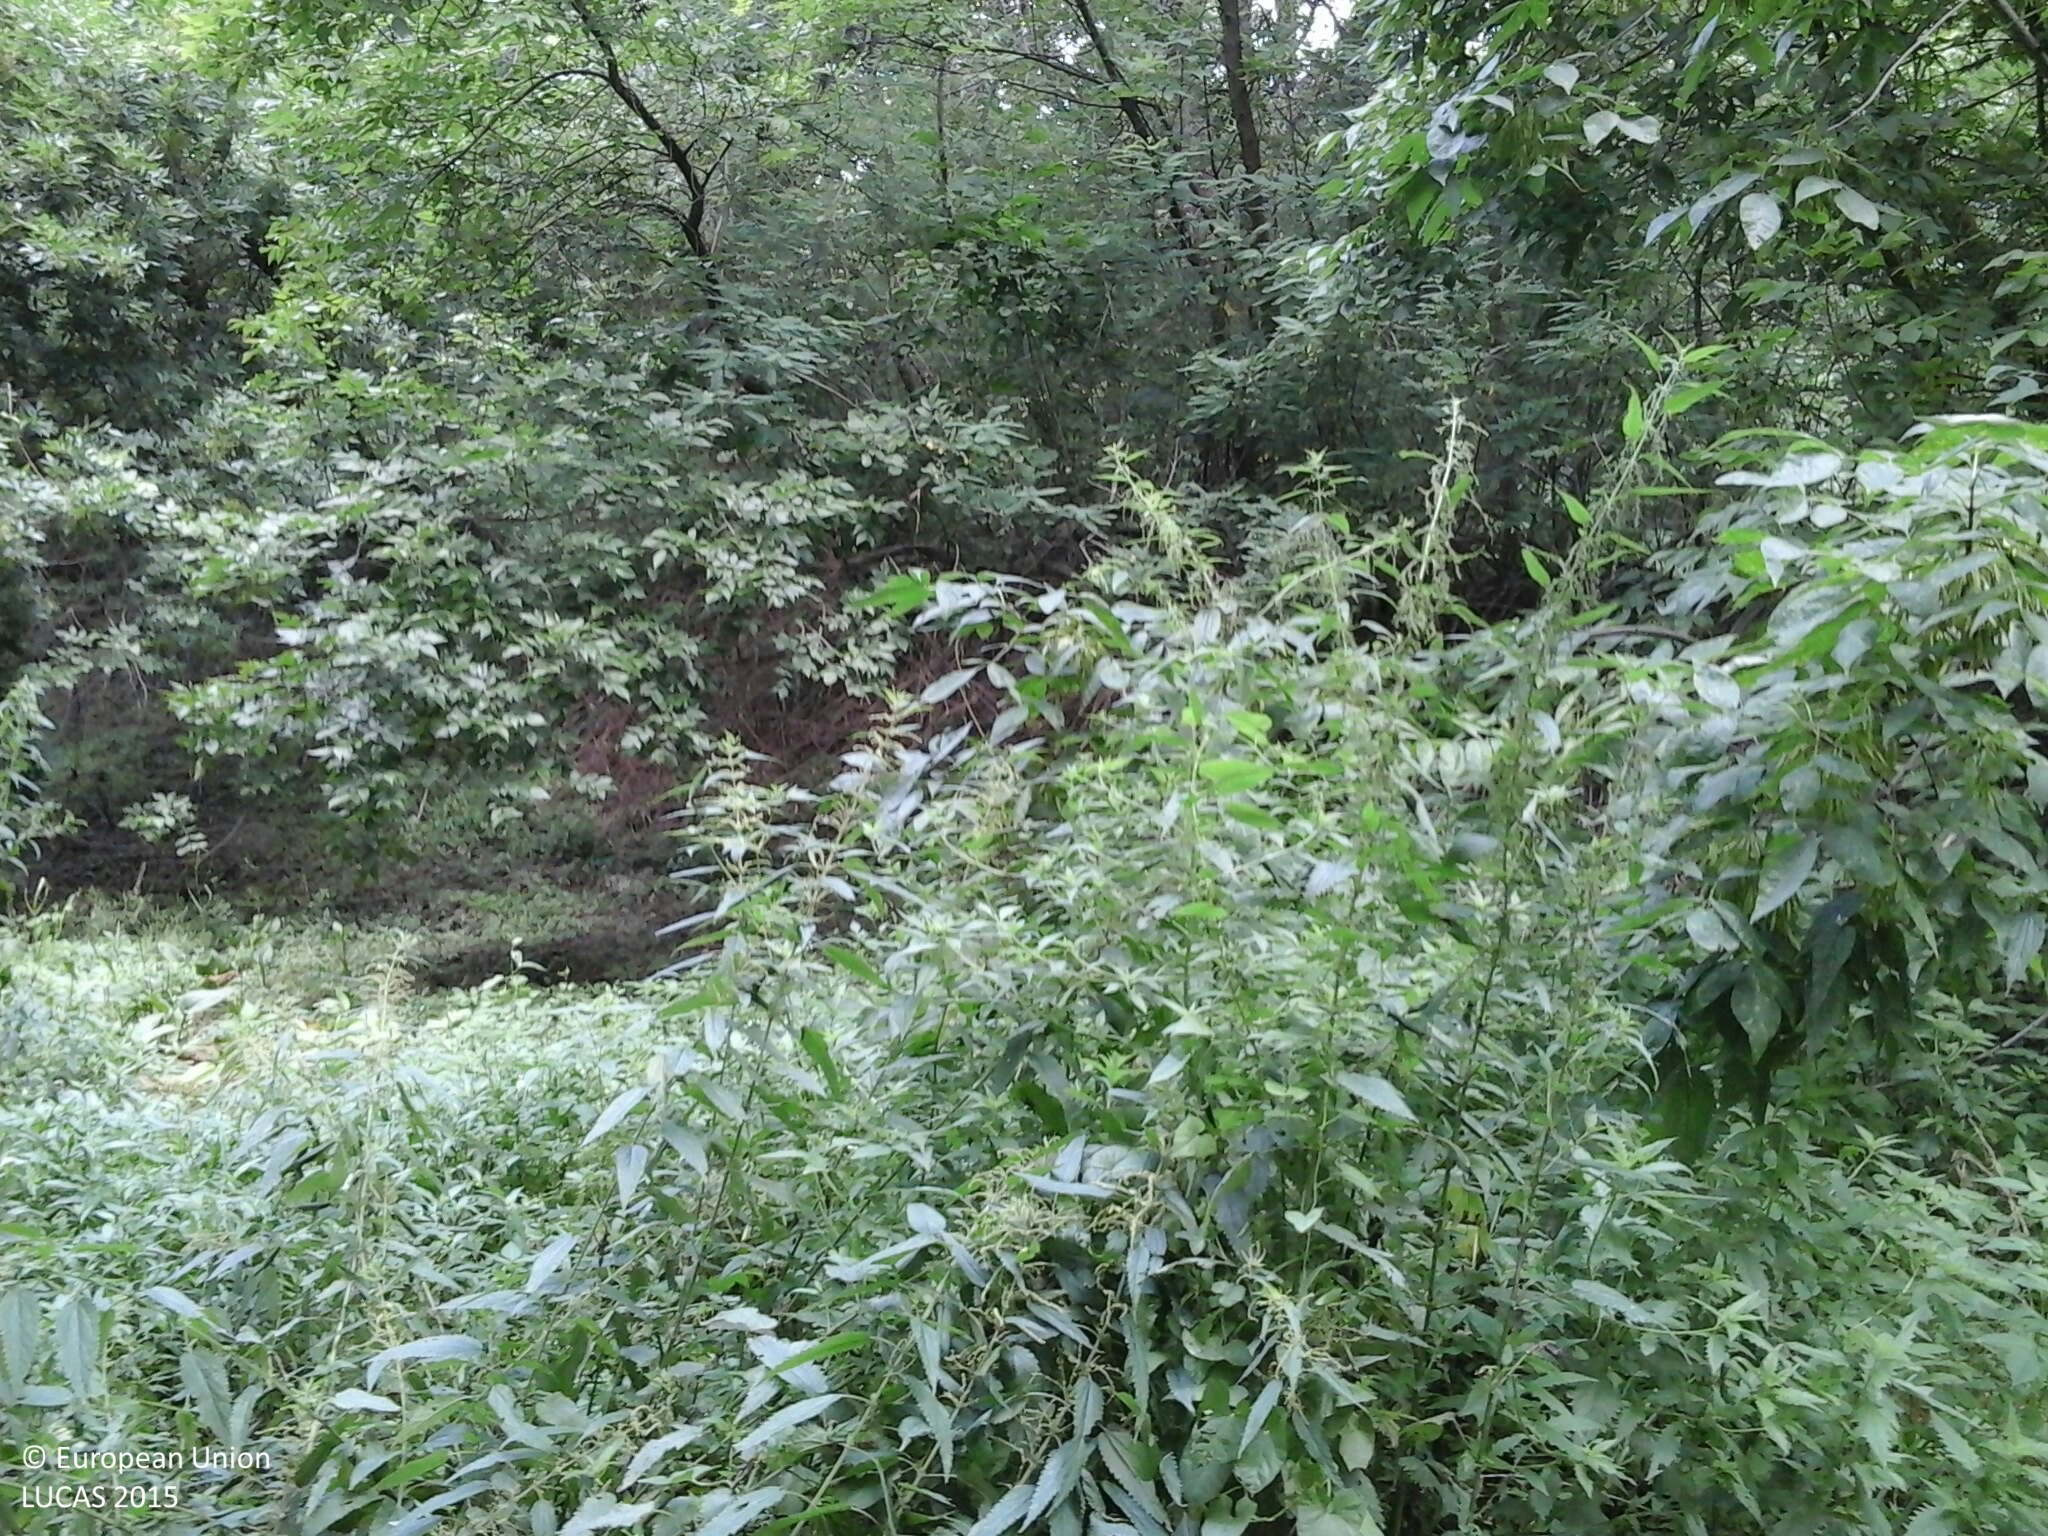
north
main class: Woodland
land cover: Broadleaved woodland
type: mesophytic deciduous forest
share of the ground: > 75 %
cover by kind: broadleaved forest trees 100 %
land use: Forestry
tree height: > 5 m
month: July
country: HU
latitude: 47.7630
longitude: 20.9913
